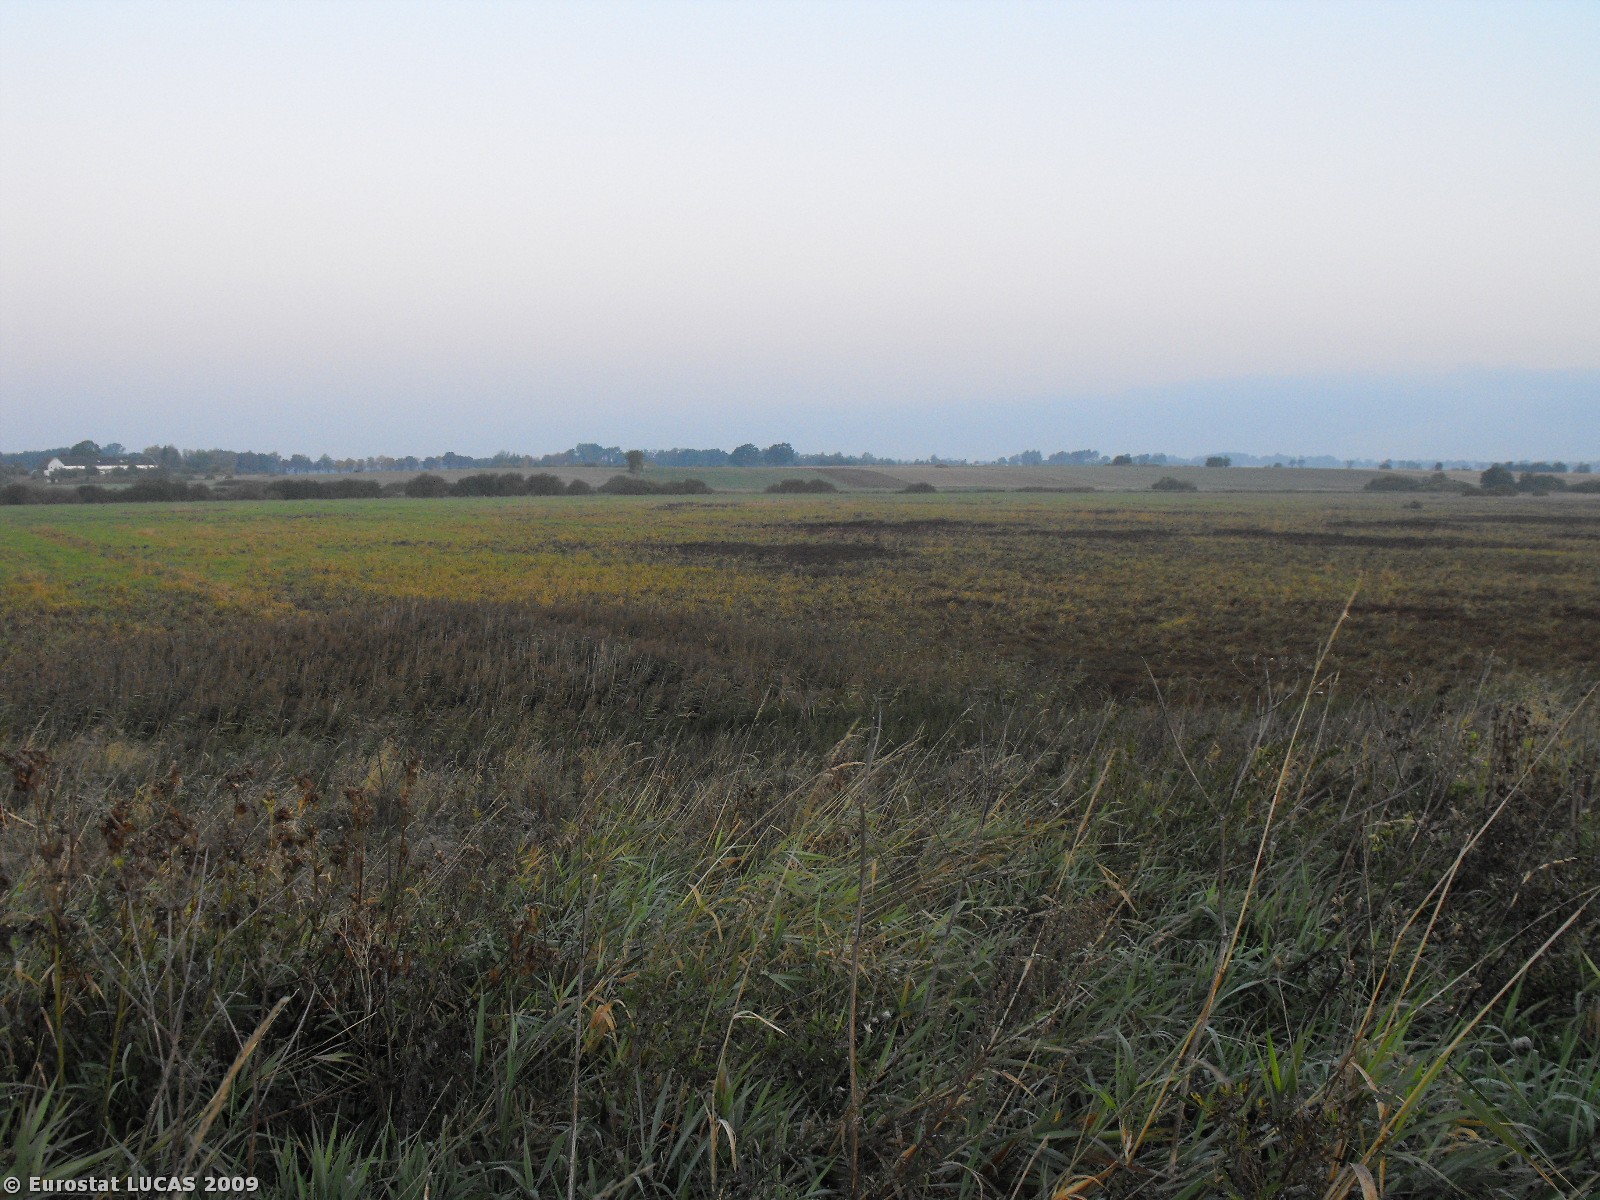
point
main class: Grassland
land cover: Spontaneously vegetated surfaces
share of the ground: > 75 %
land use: Unused
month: September
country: PL
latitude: 54.4585
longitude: 16.7478
